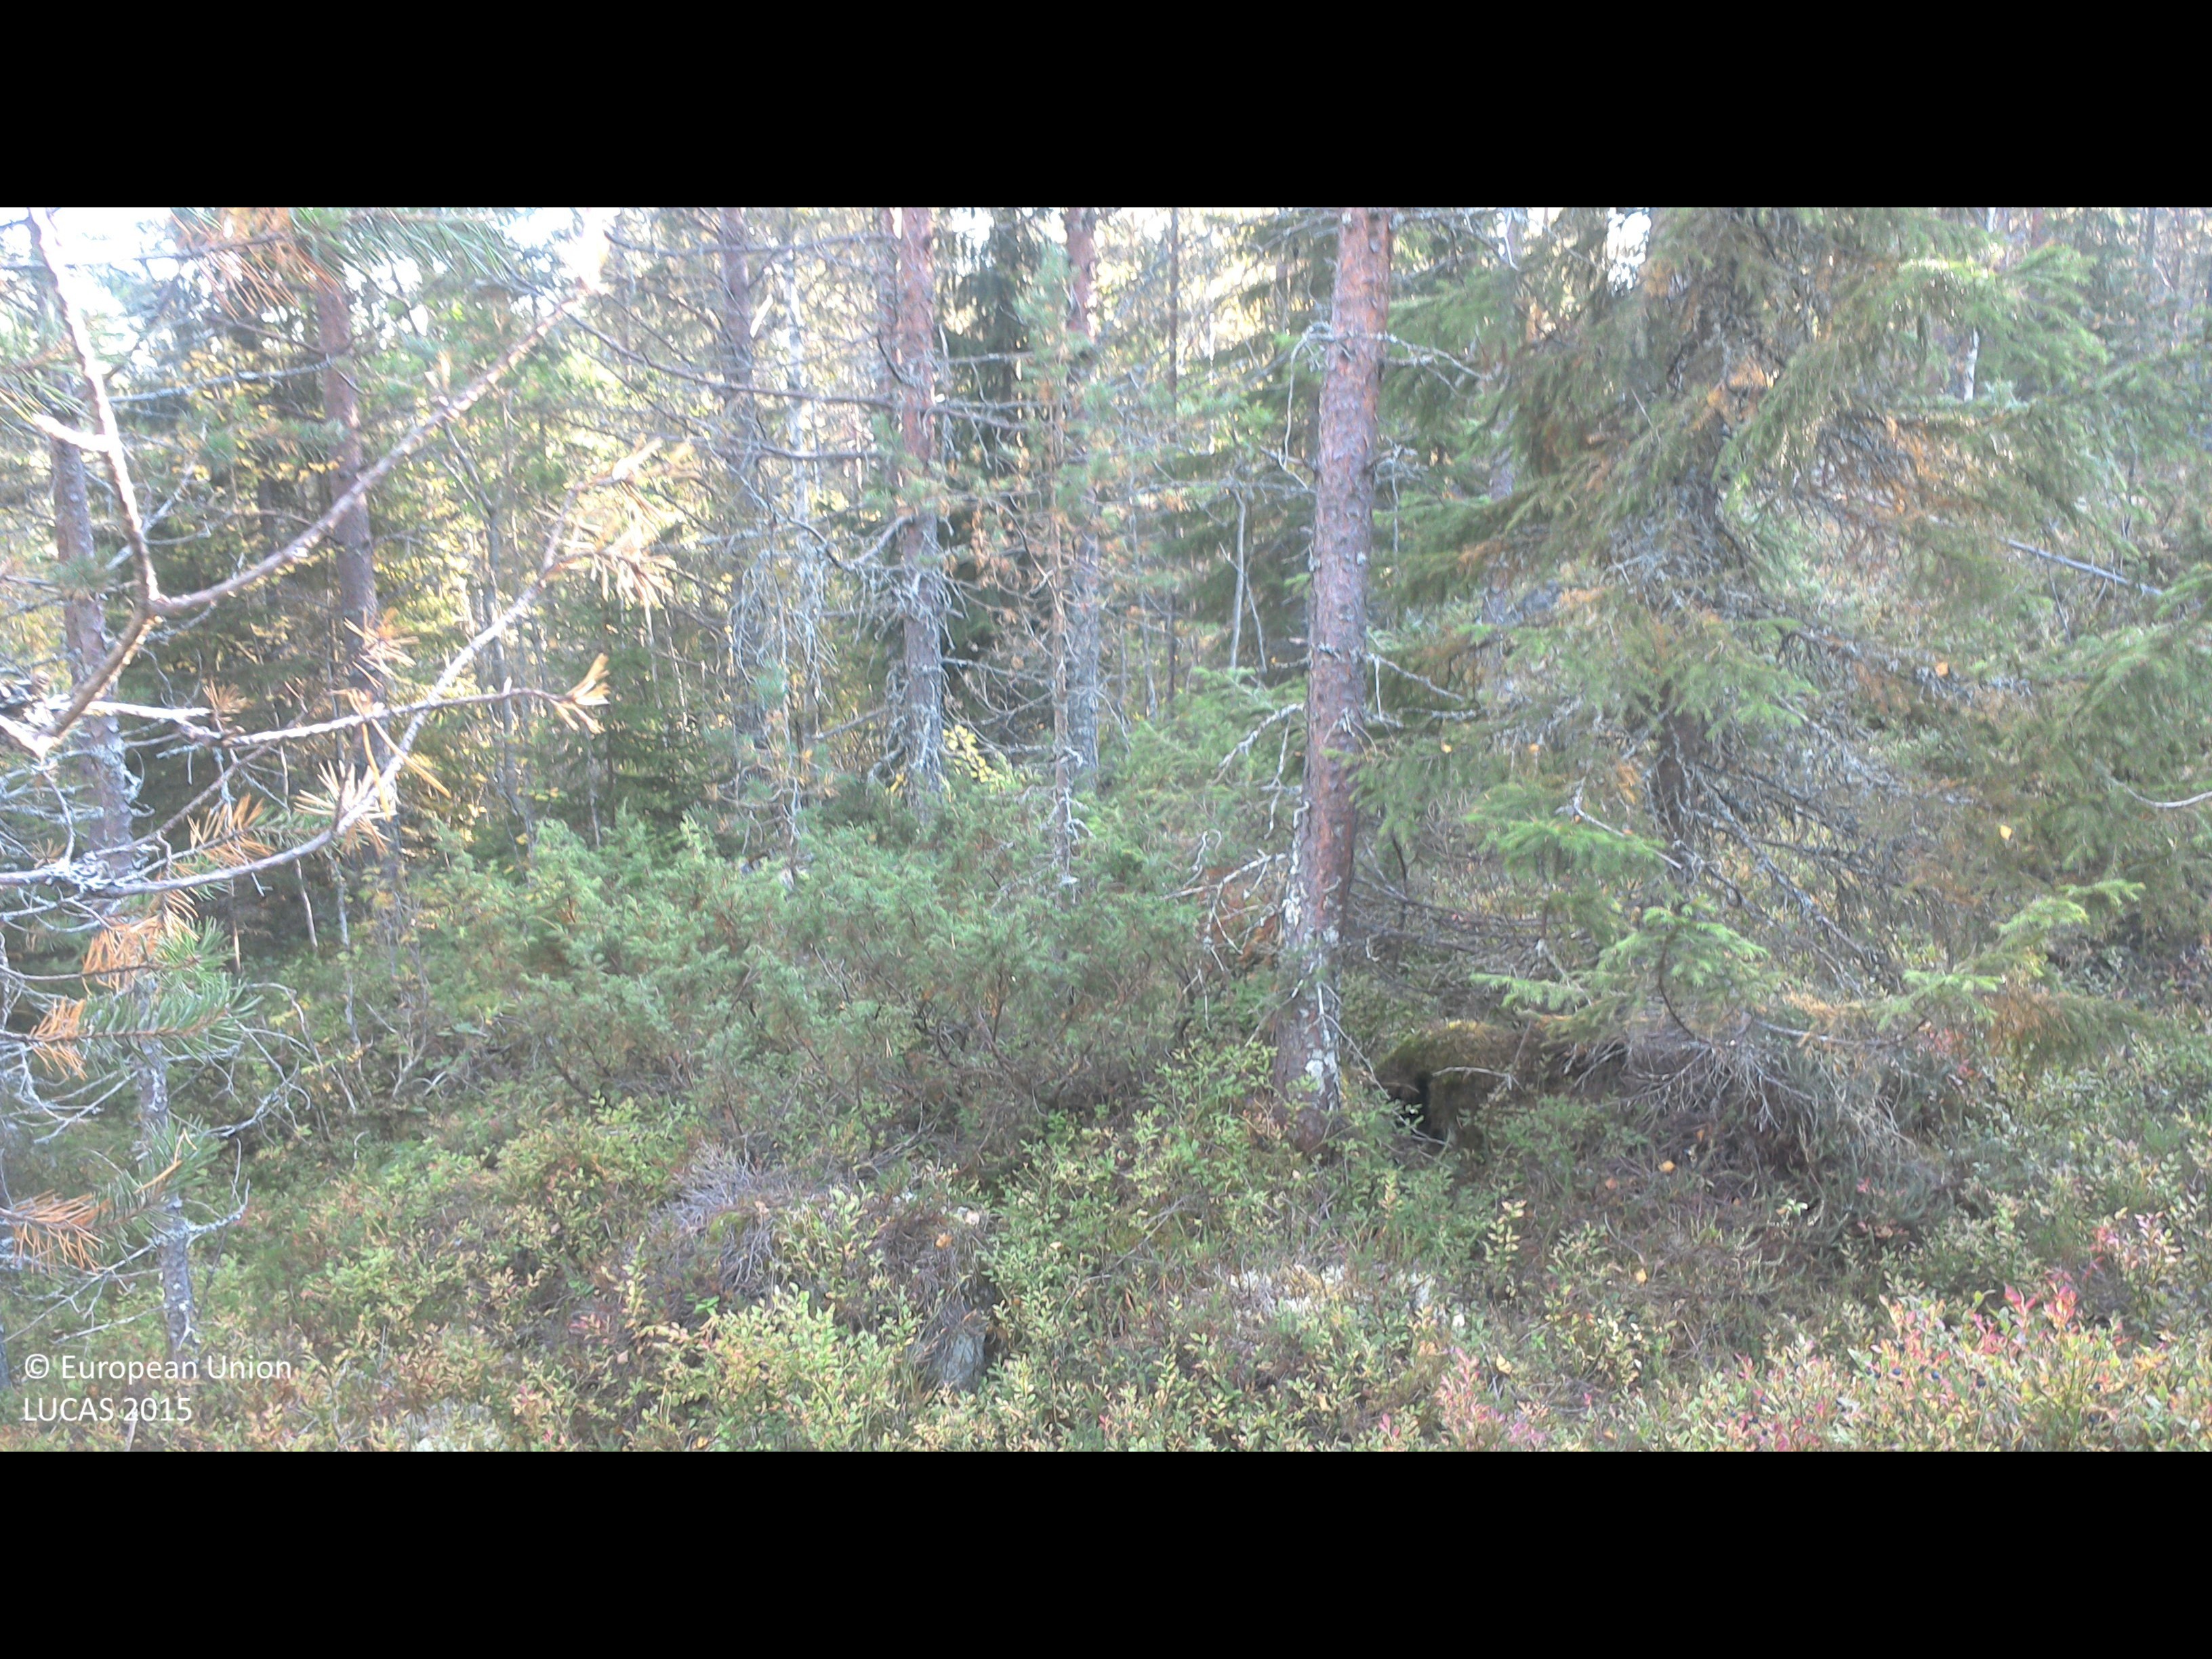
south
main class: Woodland
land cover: Pine dominated coniferous woodland
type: boreal forest
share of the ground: 50 - 75 %
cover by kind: coniferous forest trees 50 %, shrubs 50 %
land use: Forestry
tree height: > 5 m
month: September
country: SE
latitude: 63.9033
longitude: 19.9427
